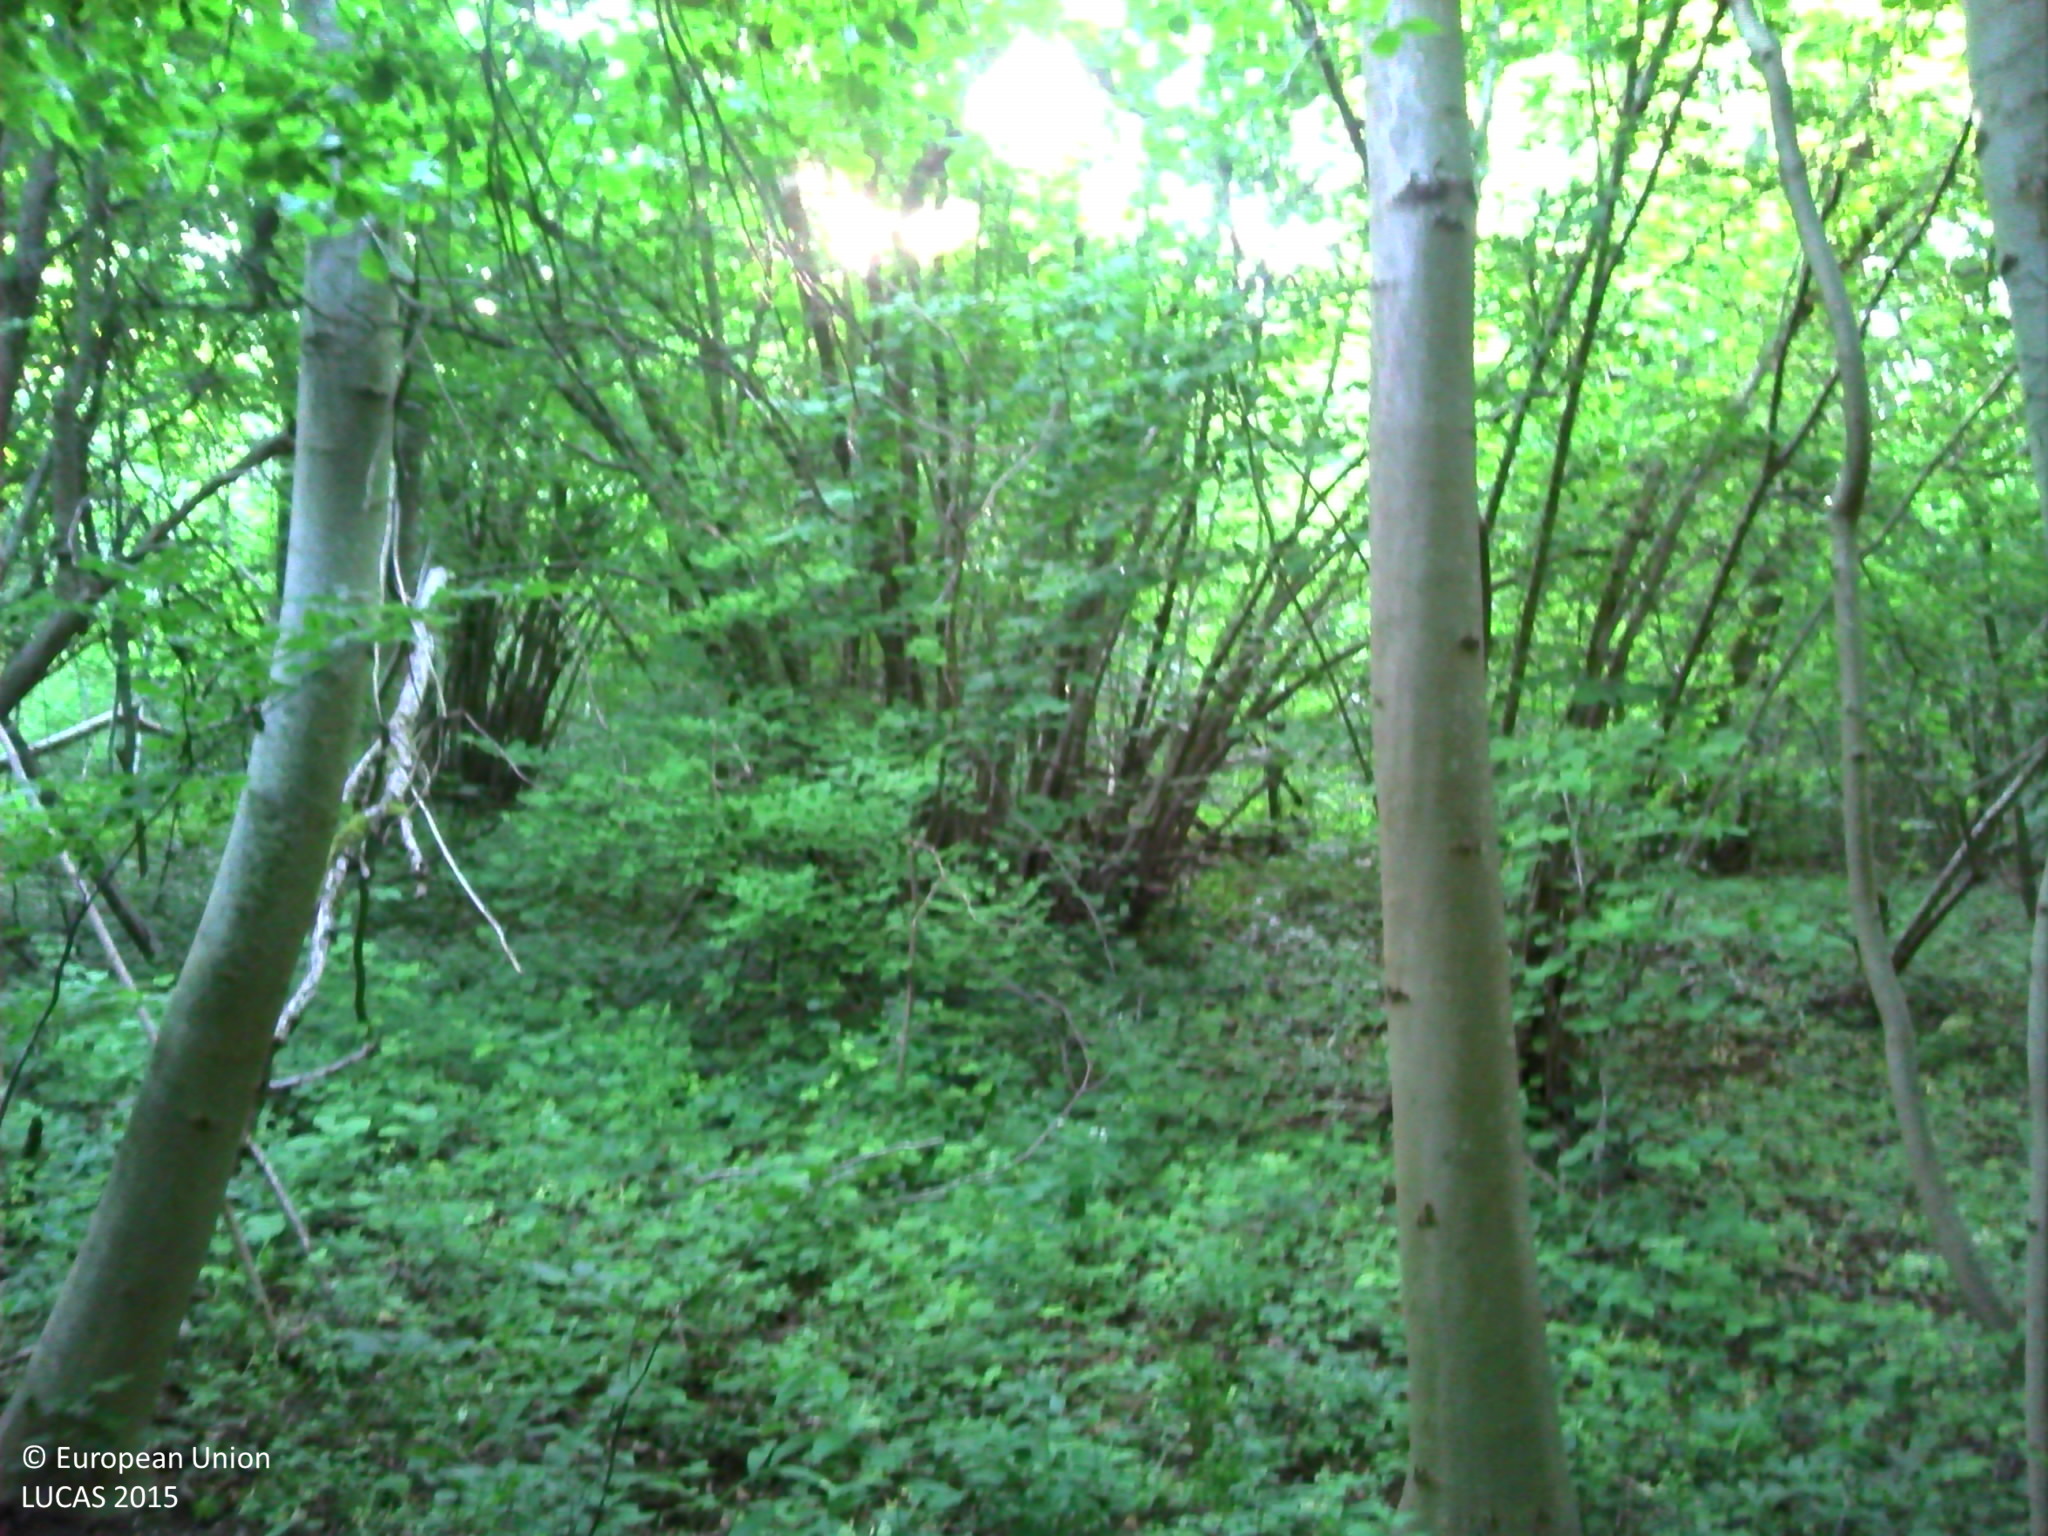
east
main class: Woodland
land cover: Broadleaved woodland
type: mesophytic deciduous forest
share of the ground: > 75 %
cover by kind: broadleaved forest trees 85 %, shrubs 10 %, herbaceous plants 5 %
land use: Forestry
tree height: > 5 m
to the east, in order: Broadleaved woodland; Tracks; Broadleaved woodland
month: June
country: FR
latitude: 49.5423
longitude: 2.8171
